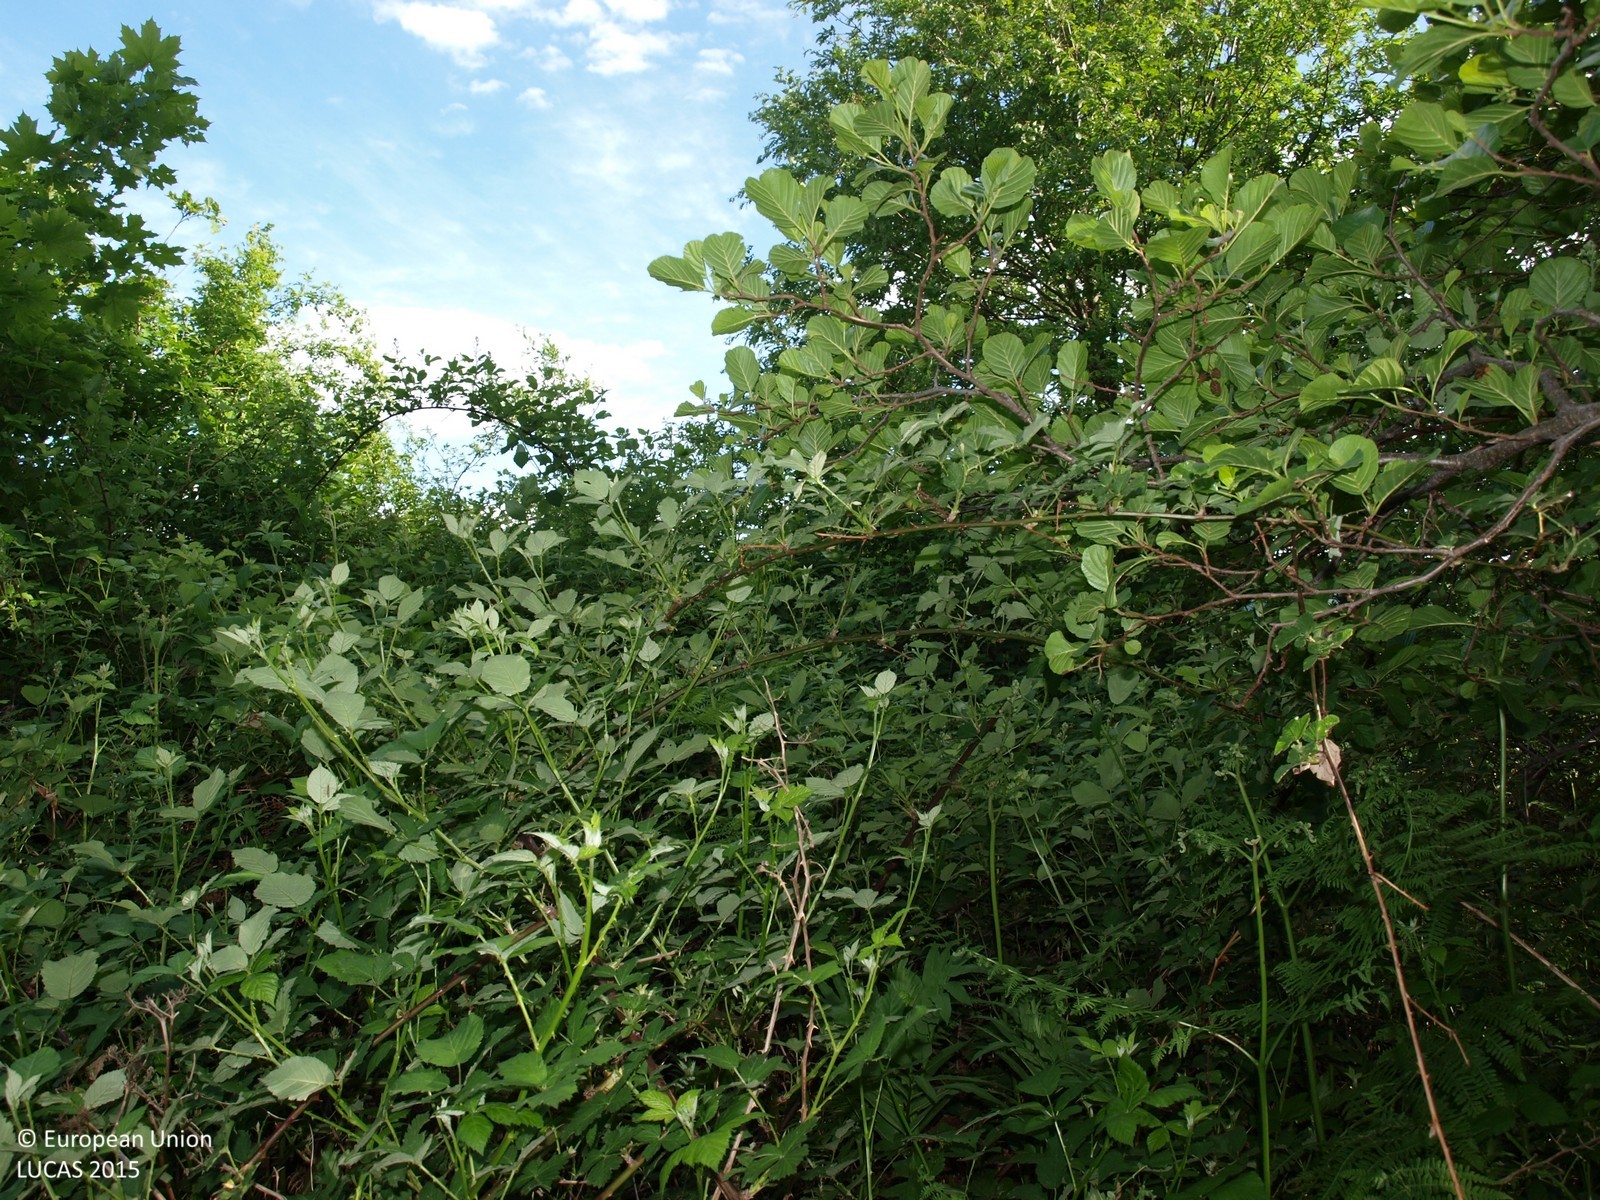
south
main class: Woodland
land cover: Broadleaved woodland
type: mesophytic deciduous forest
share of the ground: > 75 %
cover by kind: broadleaved forest trees 60 %, shrubs 30 %, herbaceous plants 10 %
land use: Forestry
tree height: > 5 m
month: May
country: HR
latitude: 46.2246
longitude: 15.8979
